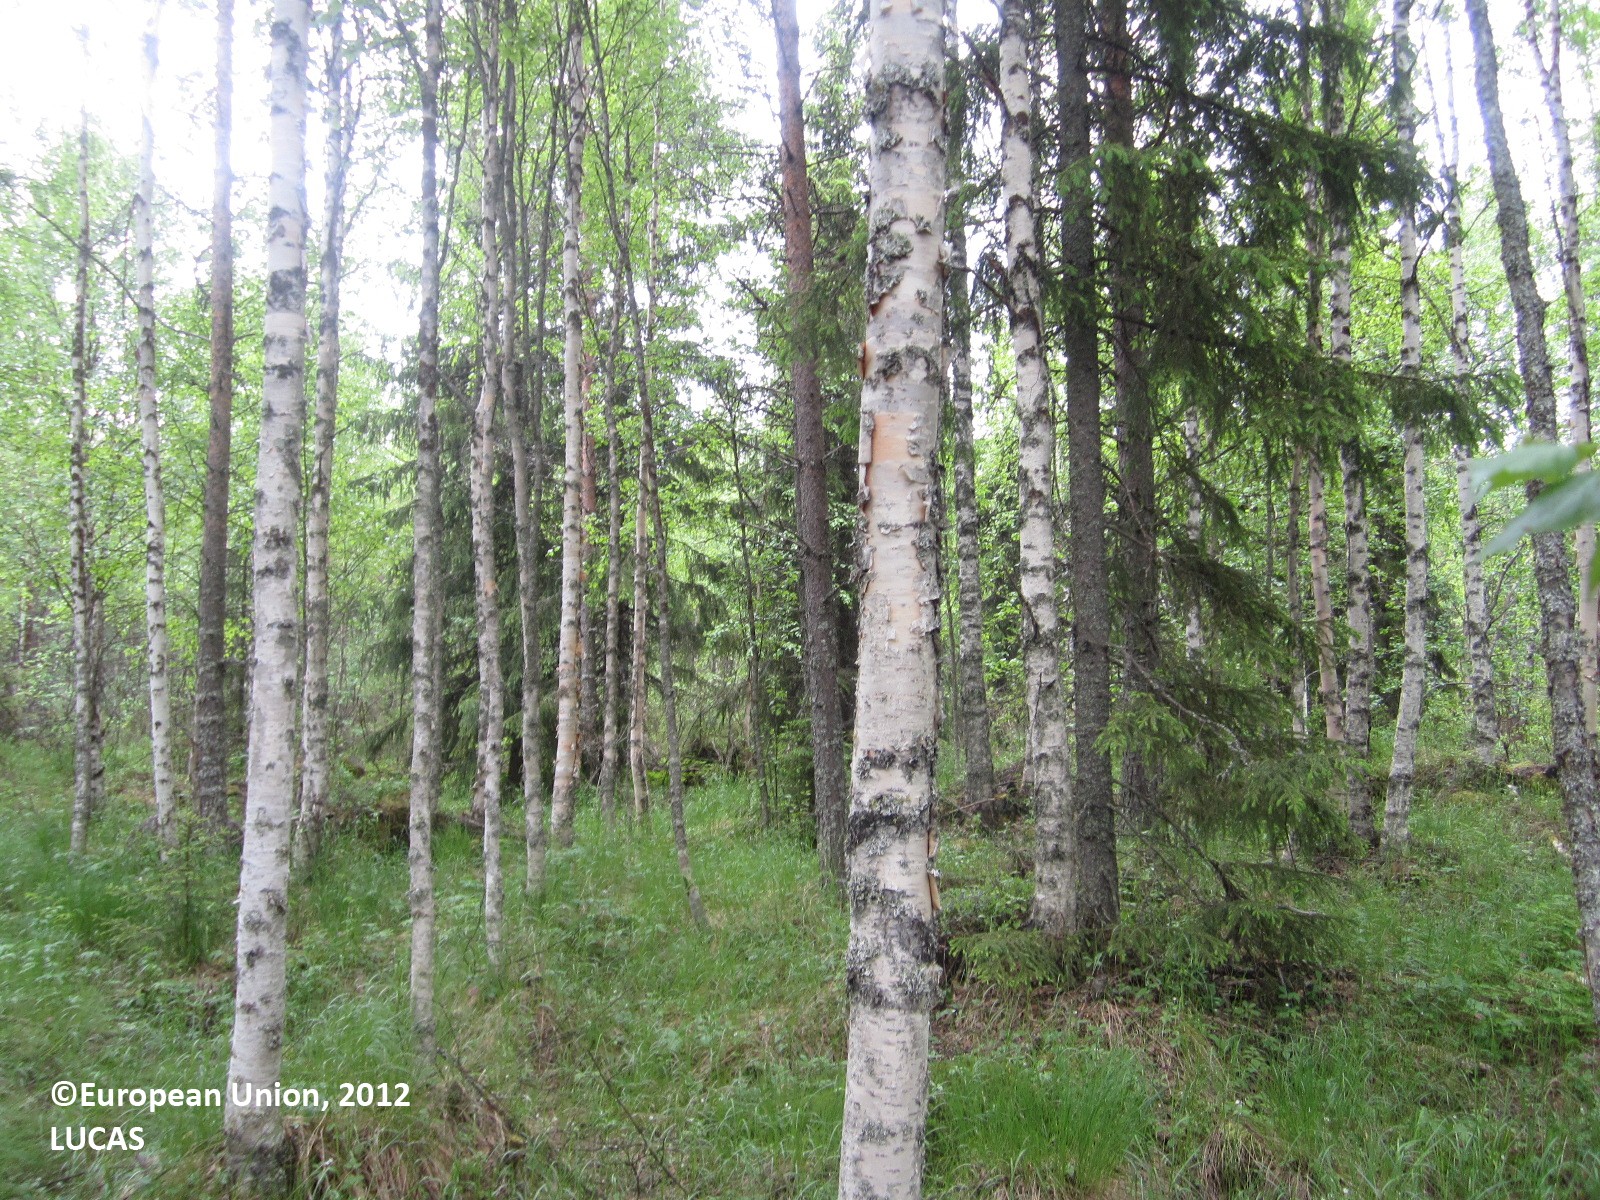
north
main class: Woodland
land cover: Broadleaved woodland
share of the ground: > 75 %
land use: Forestry
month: June
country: FI
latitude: 64.6990
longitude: 29.7007
